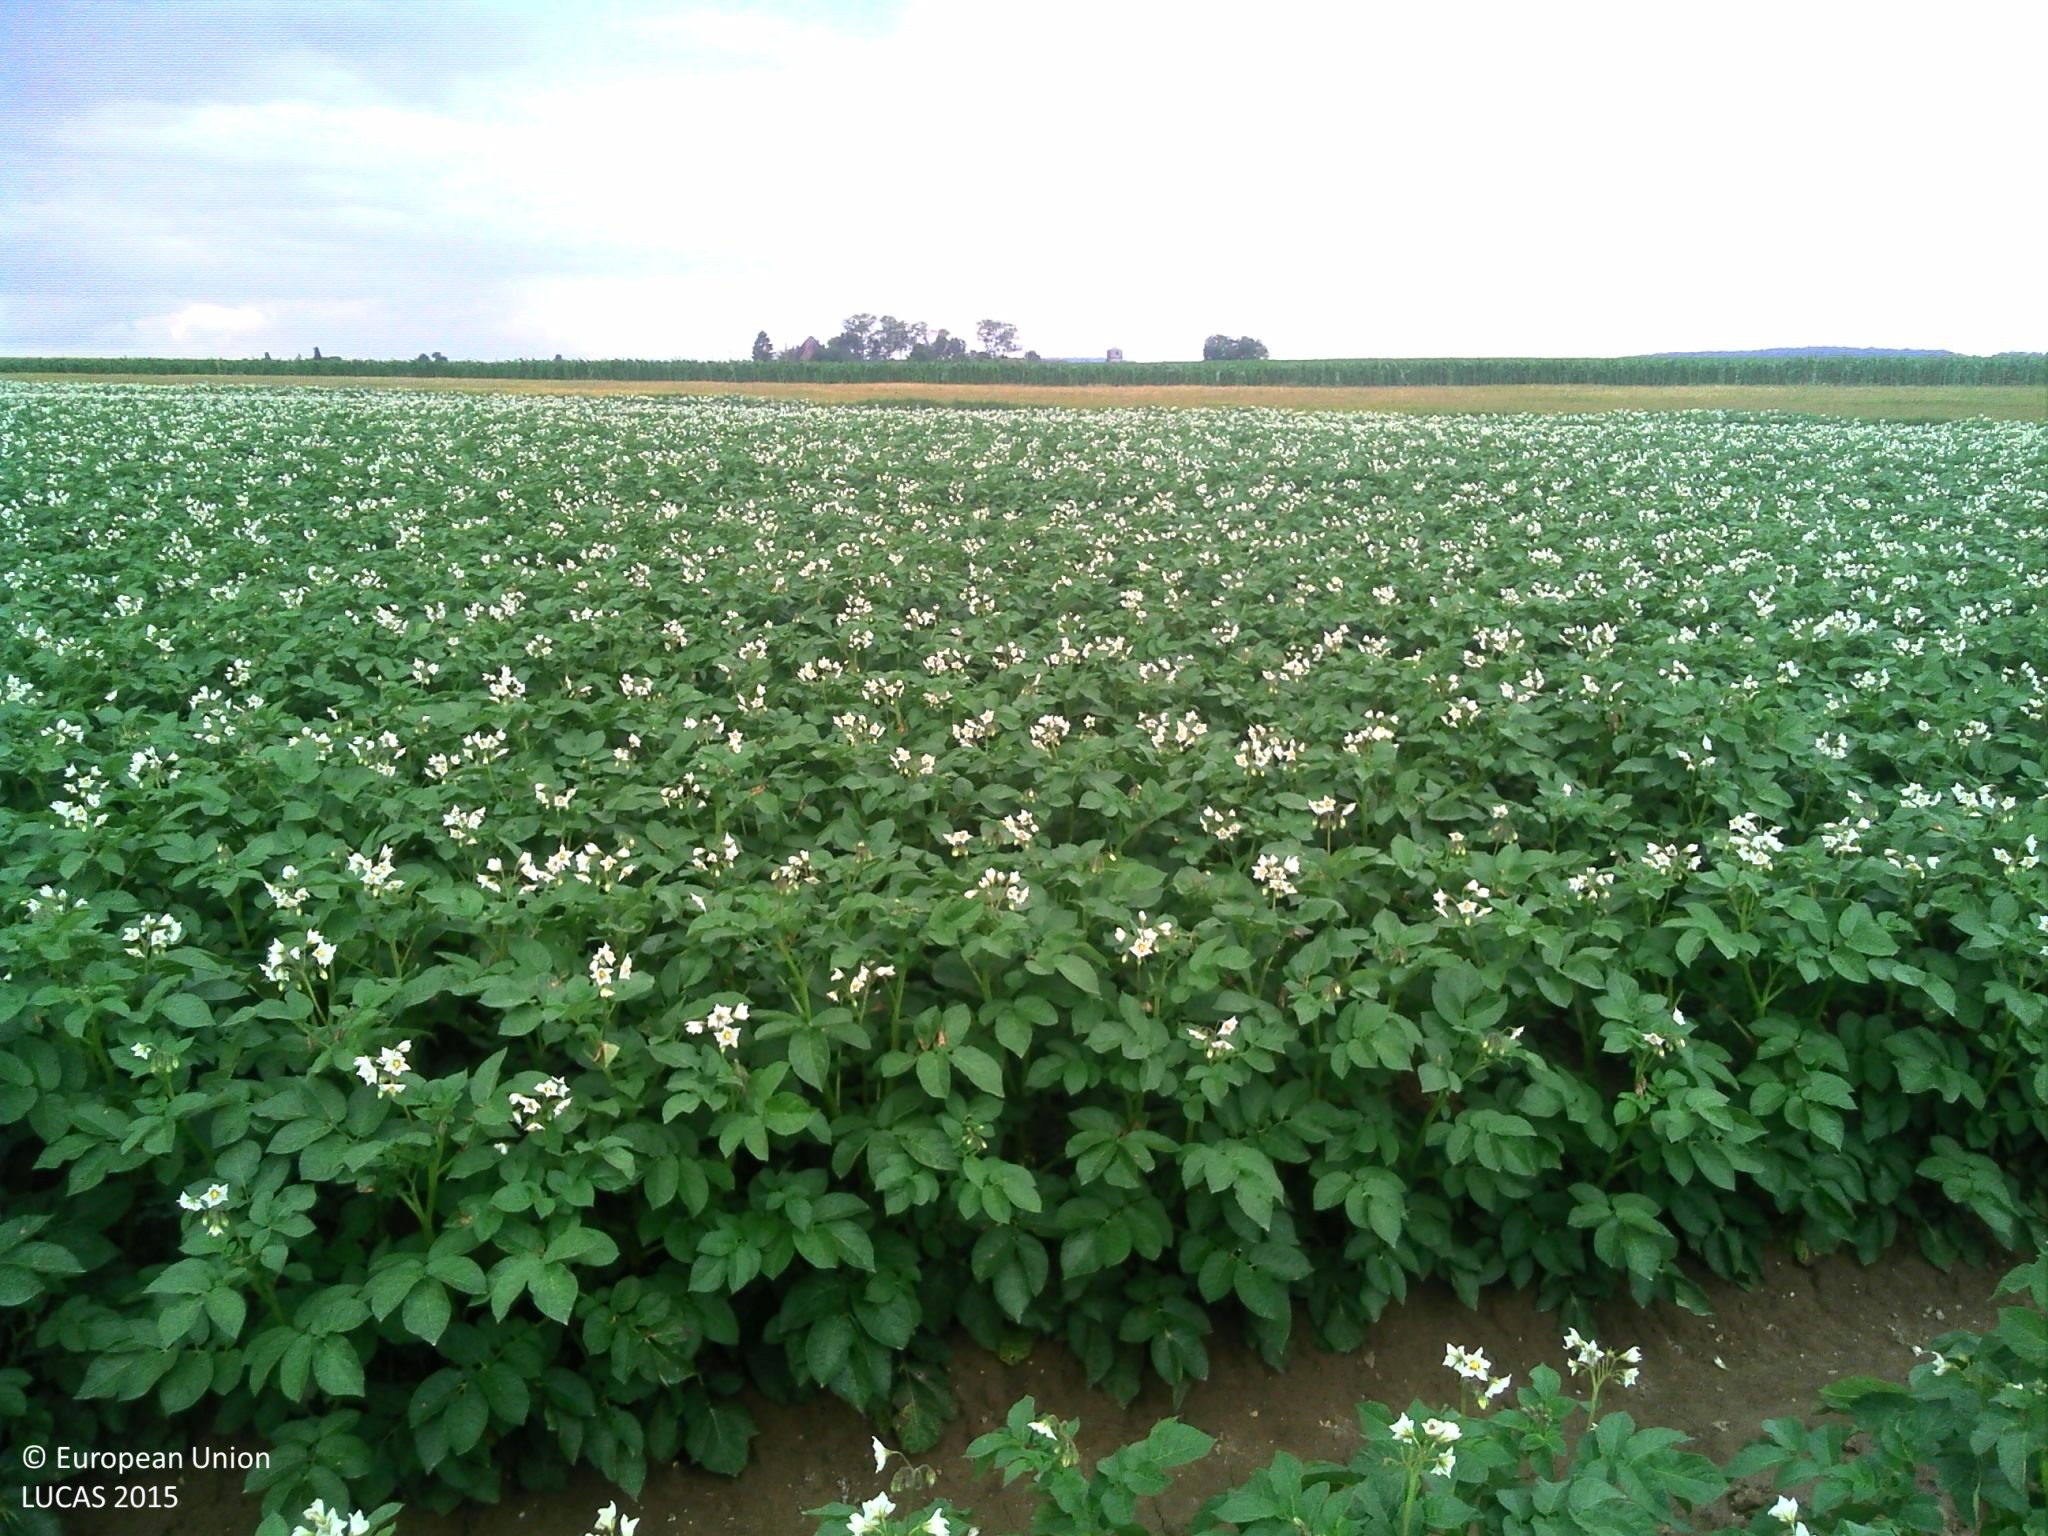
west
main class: Cropland
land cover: Potatoes
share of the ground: > 75 %
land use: Agriculture (excluding fallow land and kitchen gardens)
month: June
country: FR
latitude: 49.5904
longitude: 3.6159
